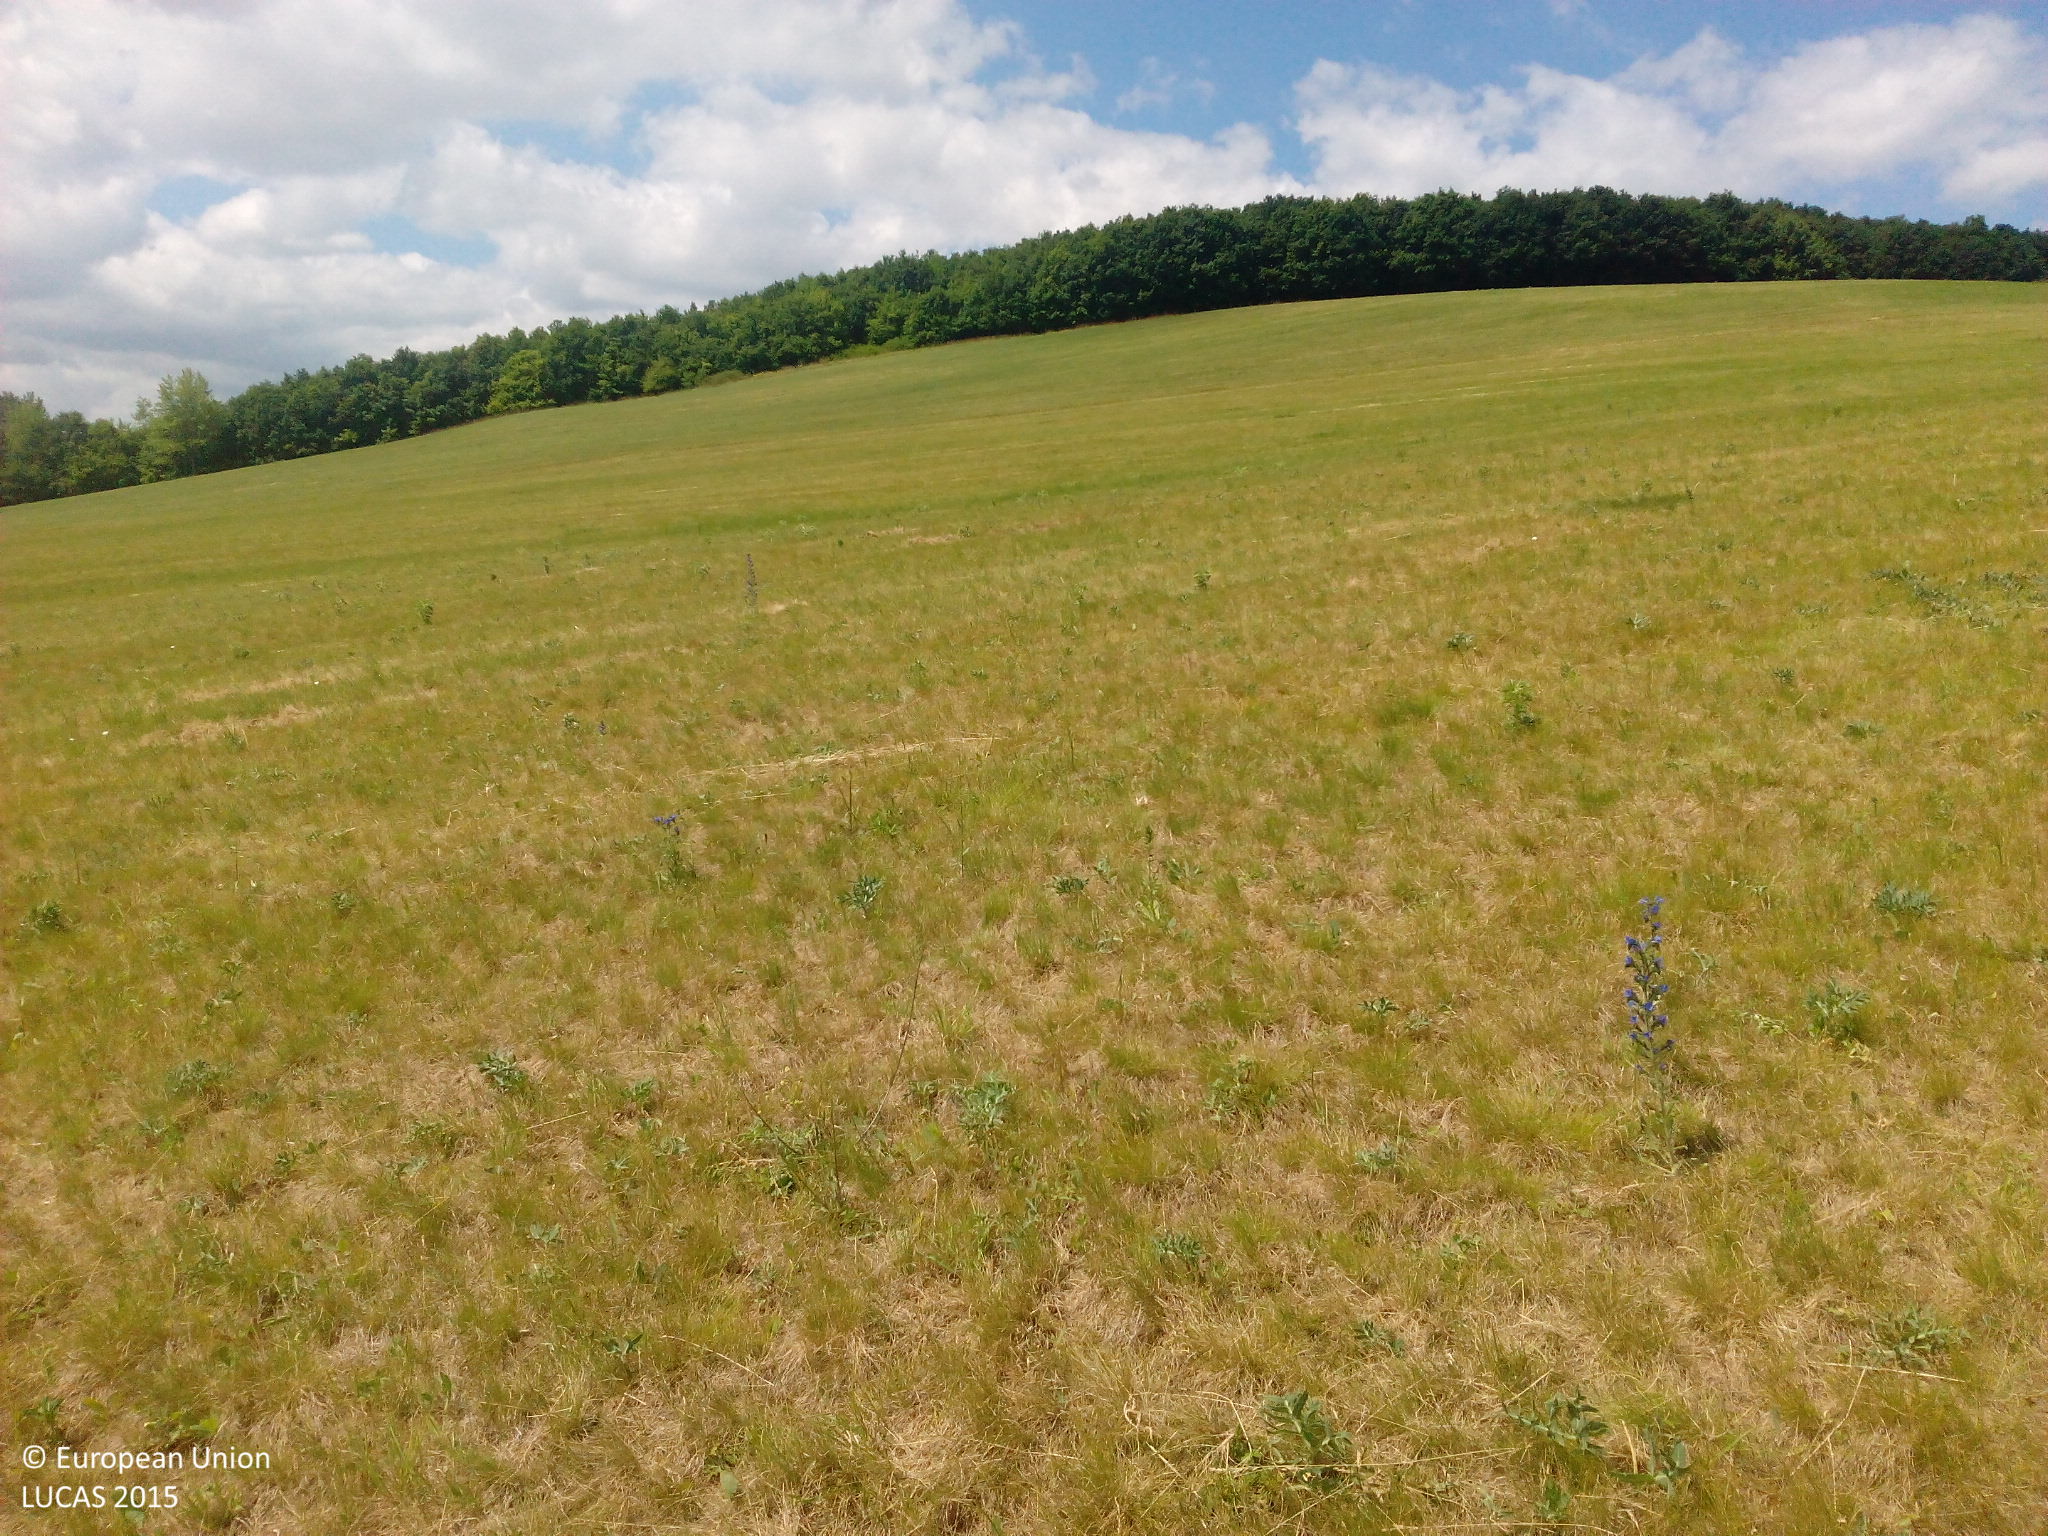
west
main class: Grassland
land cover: Grassland without tree/shrub cover
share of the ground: > 75 %
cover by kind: herbaceous plants 100 %
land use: Agriculture (excluding fallow land and kitchen gardens)
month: June
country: DE
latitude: 51.5764
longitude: 11.5436
